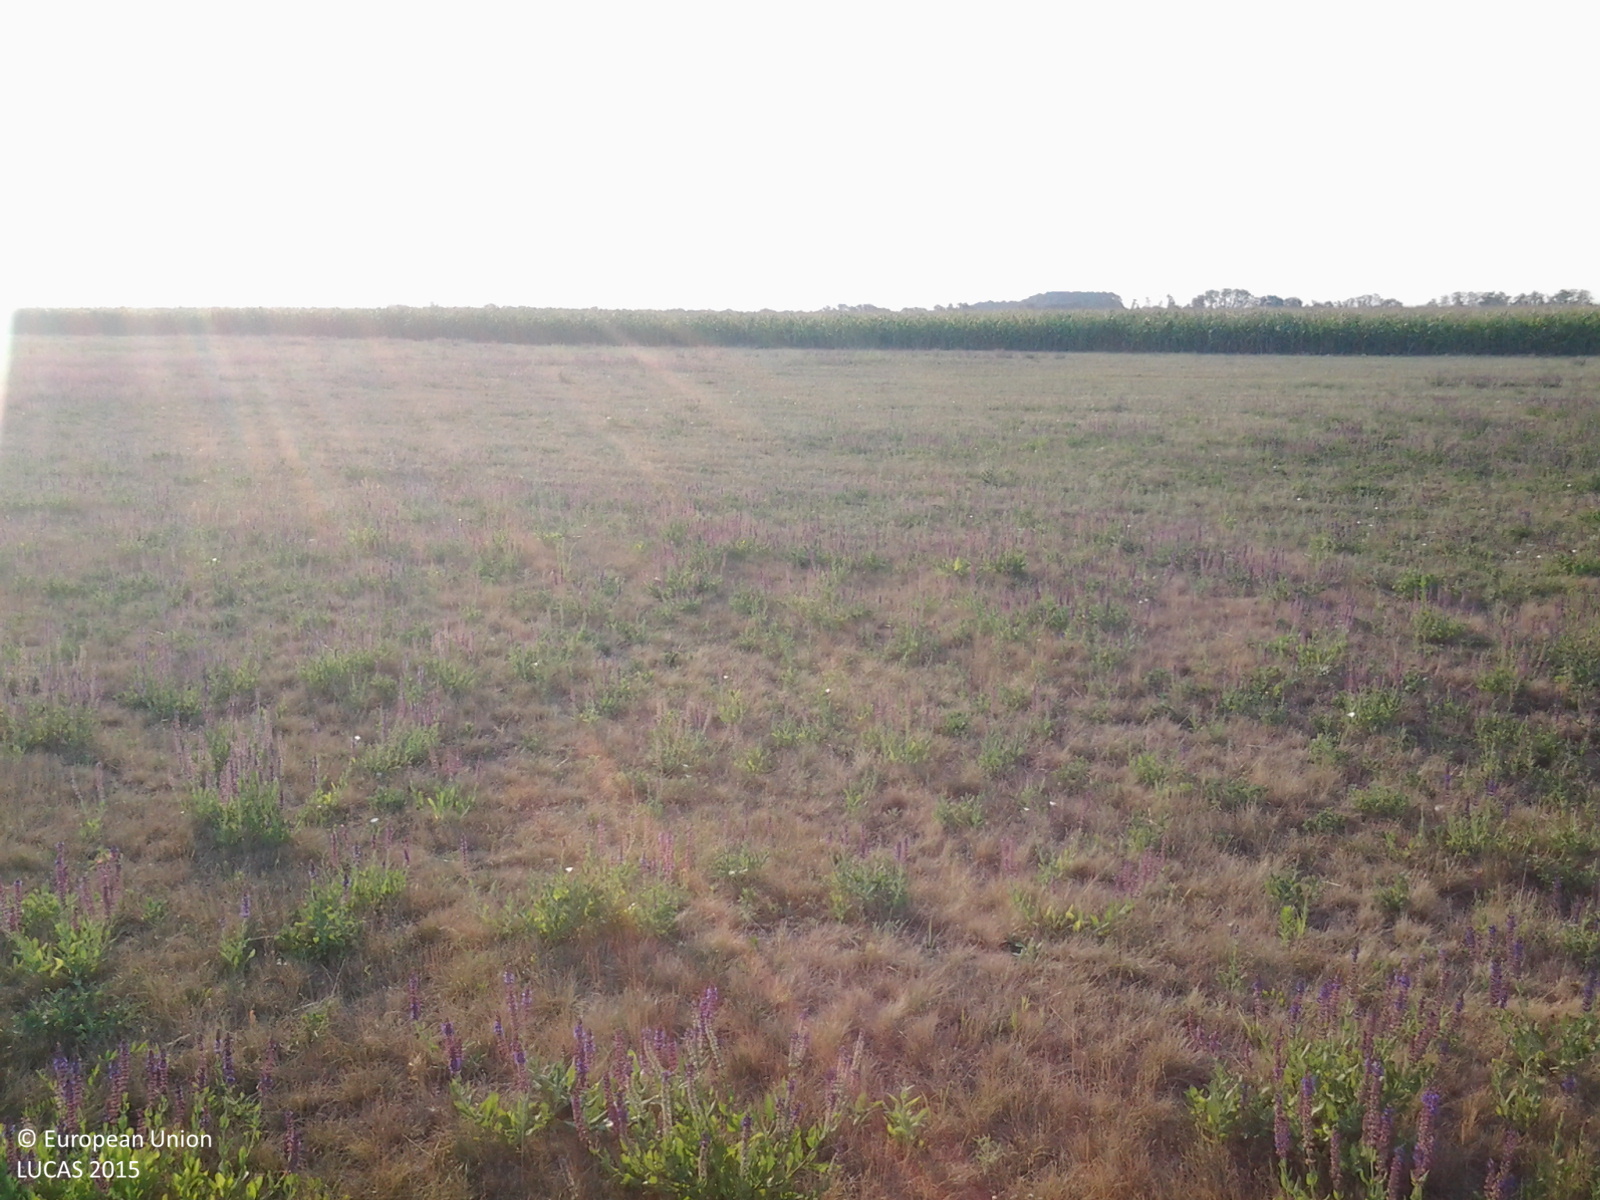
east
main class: Grassland
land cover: Grassland without tree/shrub cover
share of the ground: > 75 %
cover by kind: herbaceous plants 100 %
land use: Agriculture (excluding fallow land and kitchen gardens)
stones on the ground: < 10 %
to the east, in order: Grassland without tree/shrub cover; Maize; Grass margins; Tracks; Grass margins; Maize
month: July
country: HU
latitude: 46.9017
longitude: 20.8887
